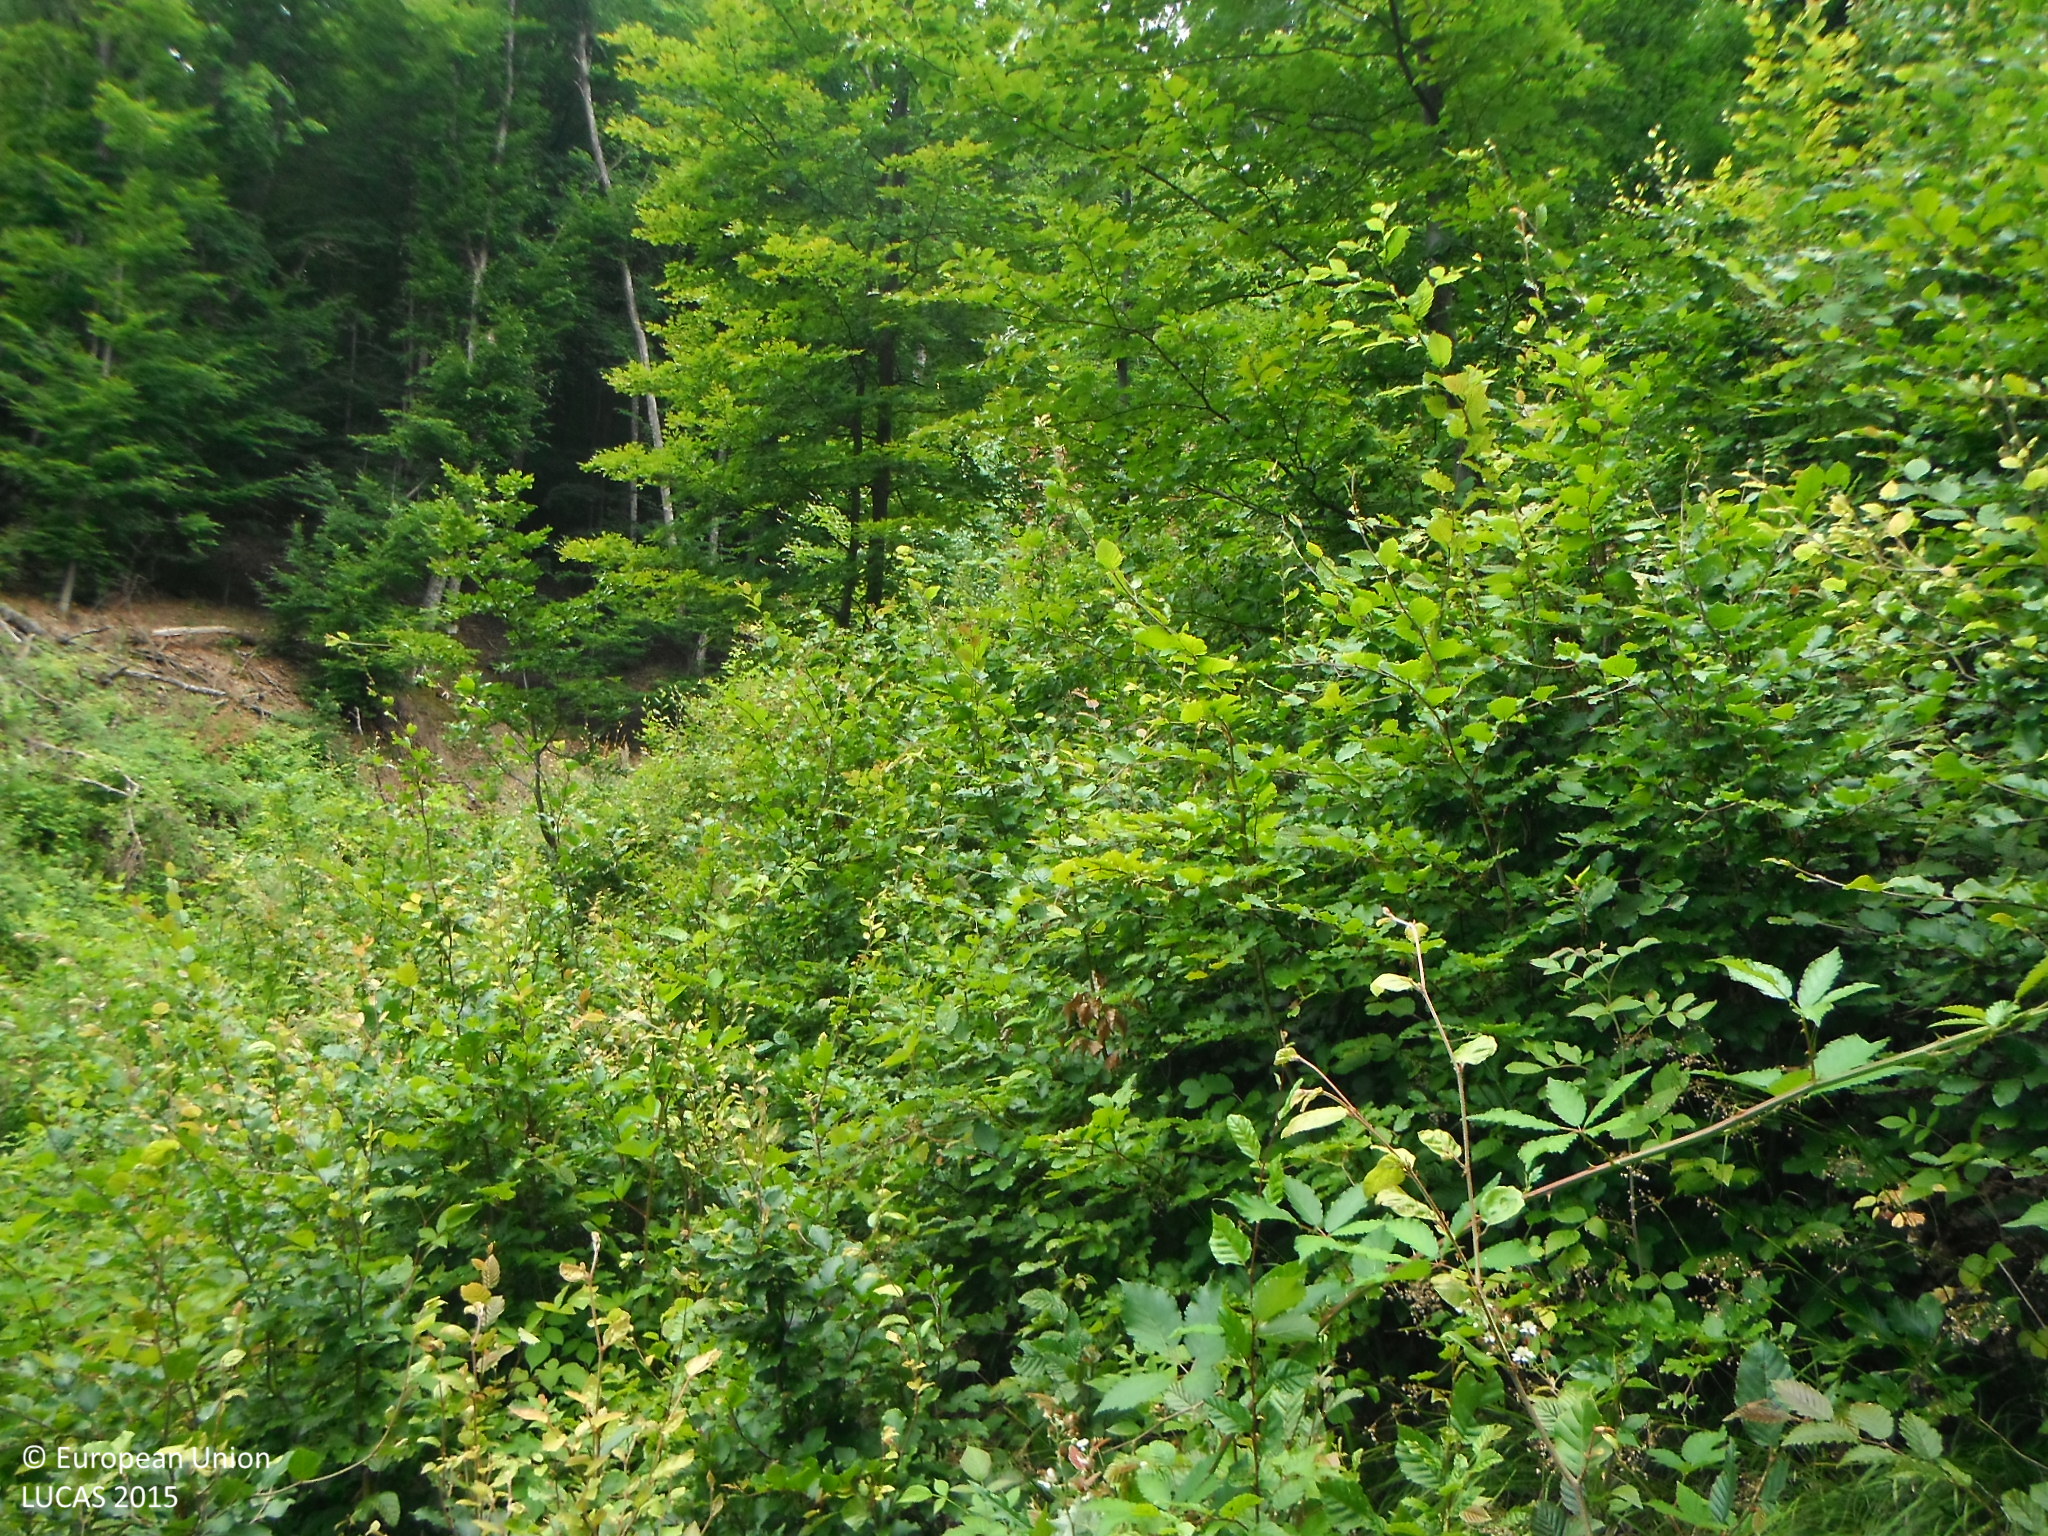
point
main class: Woodland
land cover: Broadleaved woodland
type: beech forest
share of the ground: > 75 %
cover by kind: broadleaved forest trees 90 %, shrubs 10 %
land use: Forestry
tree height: < 5 m
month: July
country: SK
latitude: 48.5872
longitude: 20.1585
